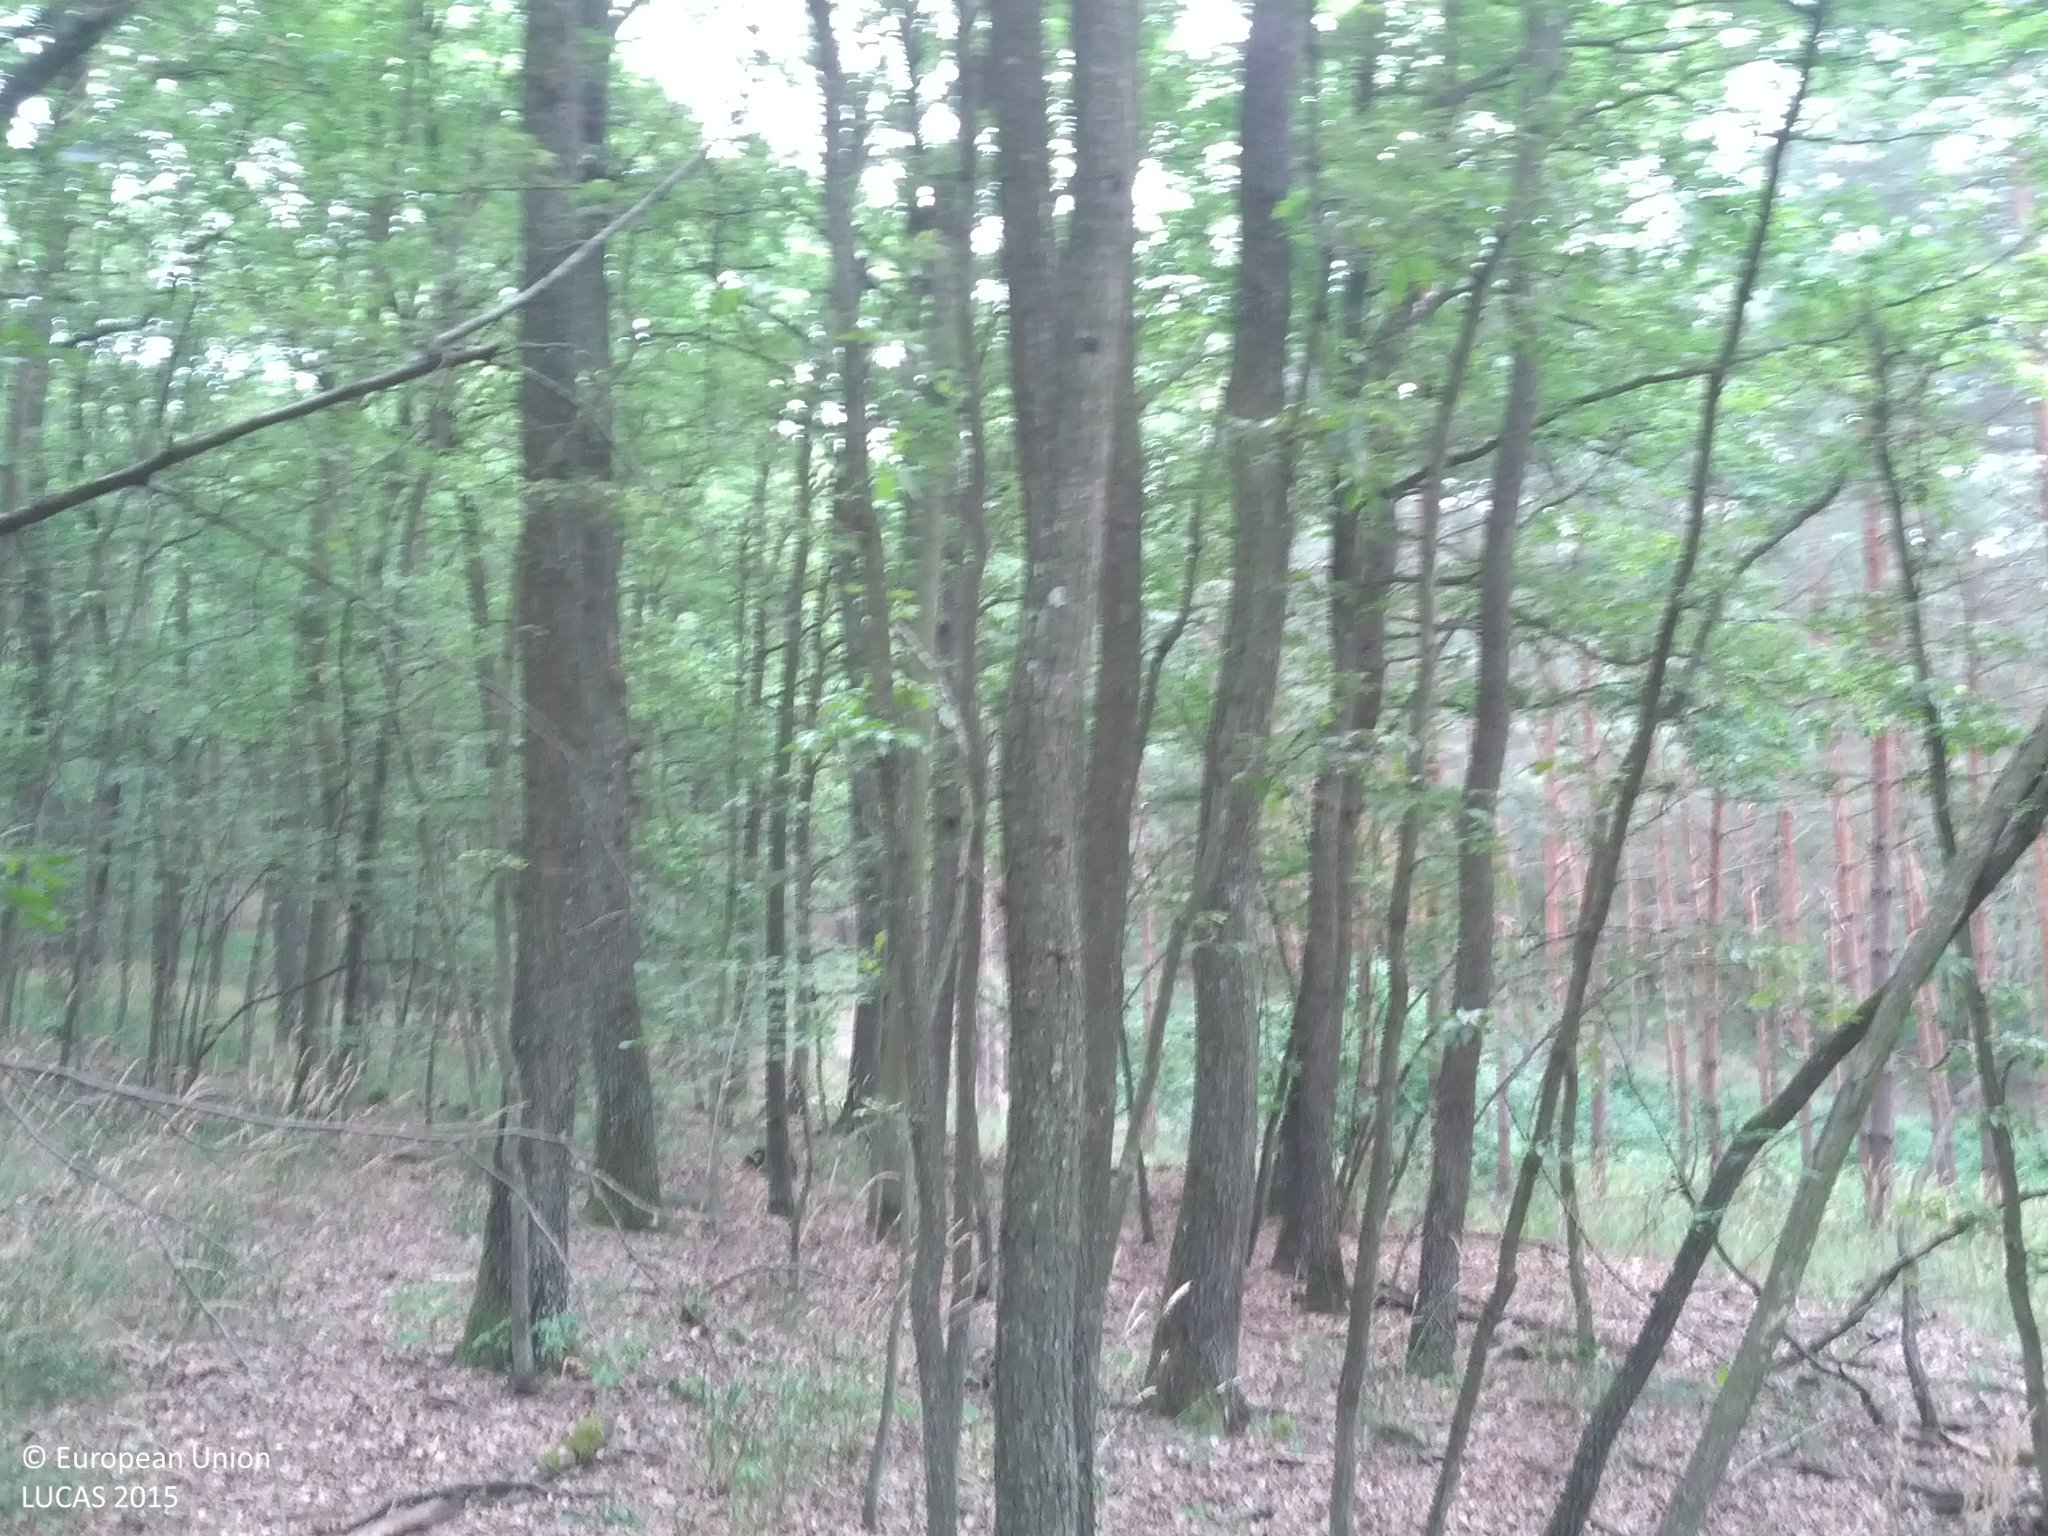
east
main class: Woodland
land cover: Broadleaved woodland
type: acidophilous oak and oak-birch forest
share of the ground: > 75 %
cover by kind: broadleaved forest trees 90 %, herbaceous plants 10 %
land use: Forestry
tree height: > 5 m
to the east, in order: Broadleaved woodland
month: July
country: AT
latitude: 48.5396
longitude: 16.1403
